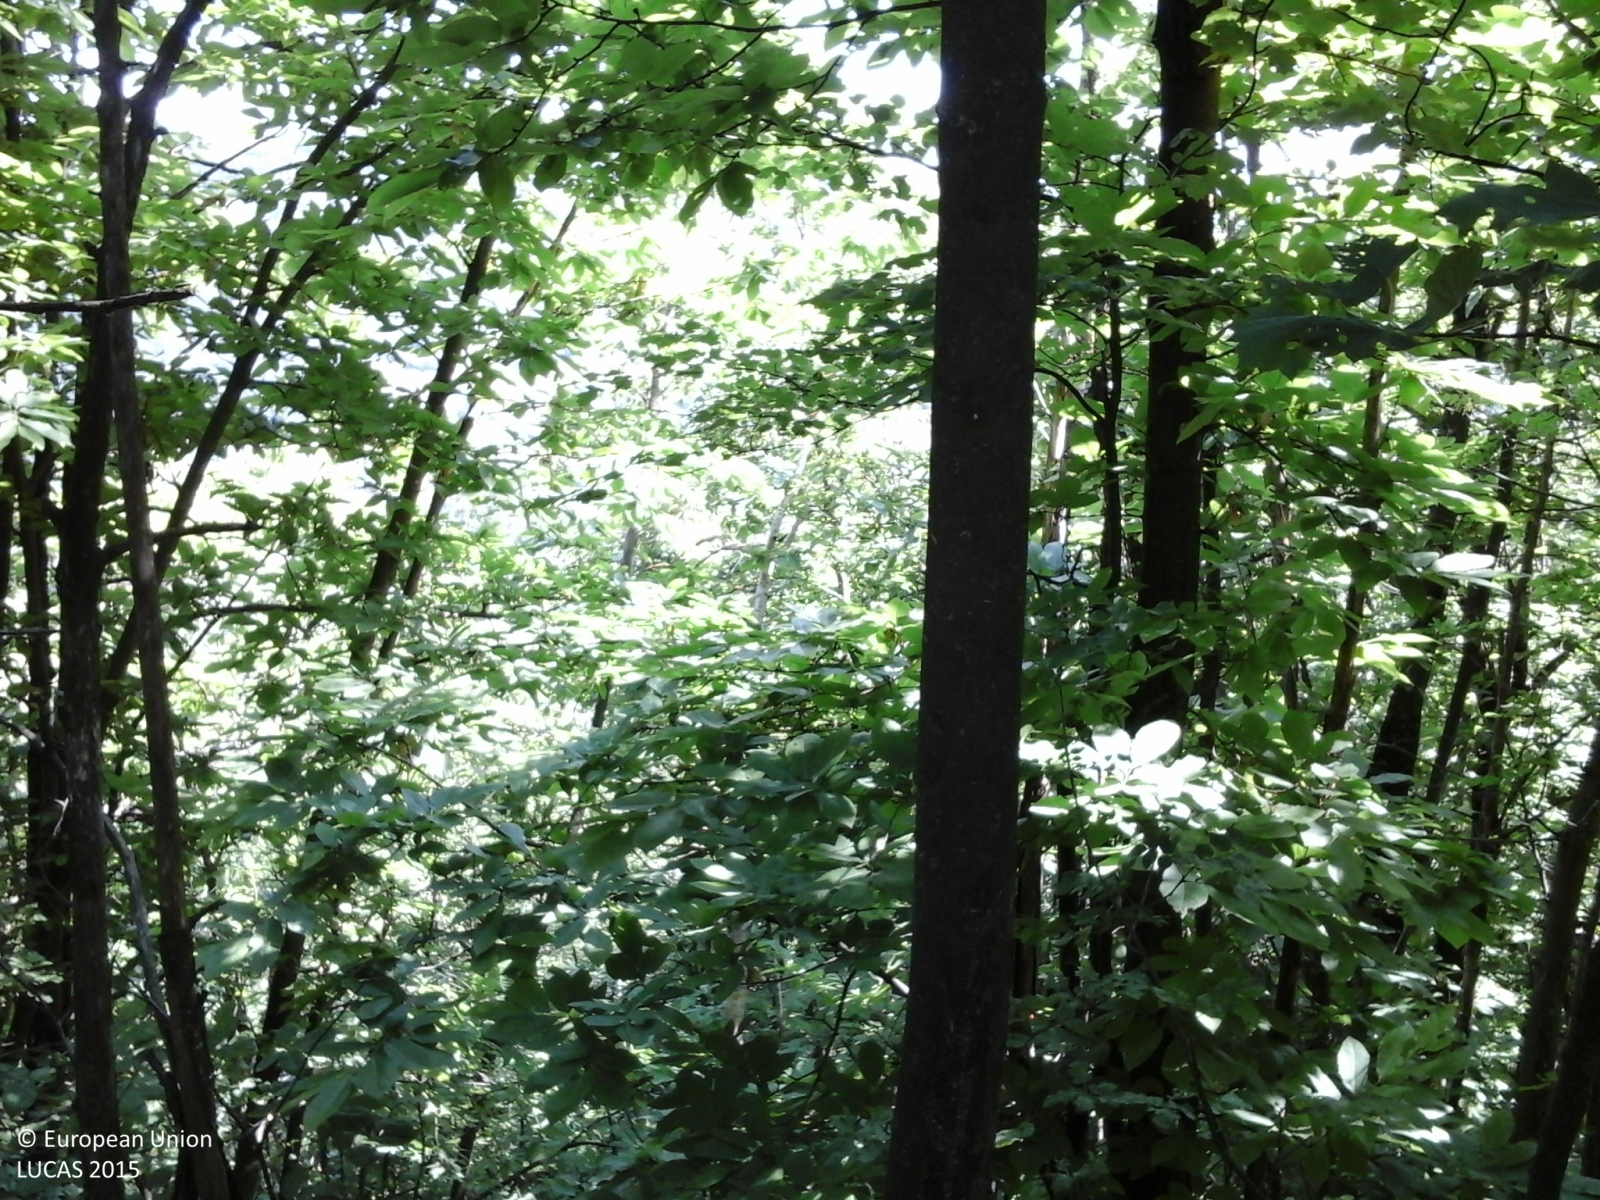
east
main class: Woodland
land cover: Broadleaved woodland
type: thermophilous deciduous forest
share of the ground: > 75 %
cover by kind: broadleaved forest trees 90 %, consolidated bare surface 10 %
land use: Forestry
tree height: > 5 m
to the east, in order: Broadleaved woodland
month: May
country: IT
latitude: 44.4206
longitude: 10.6642
